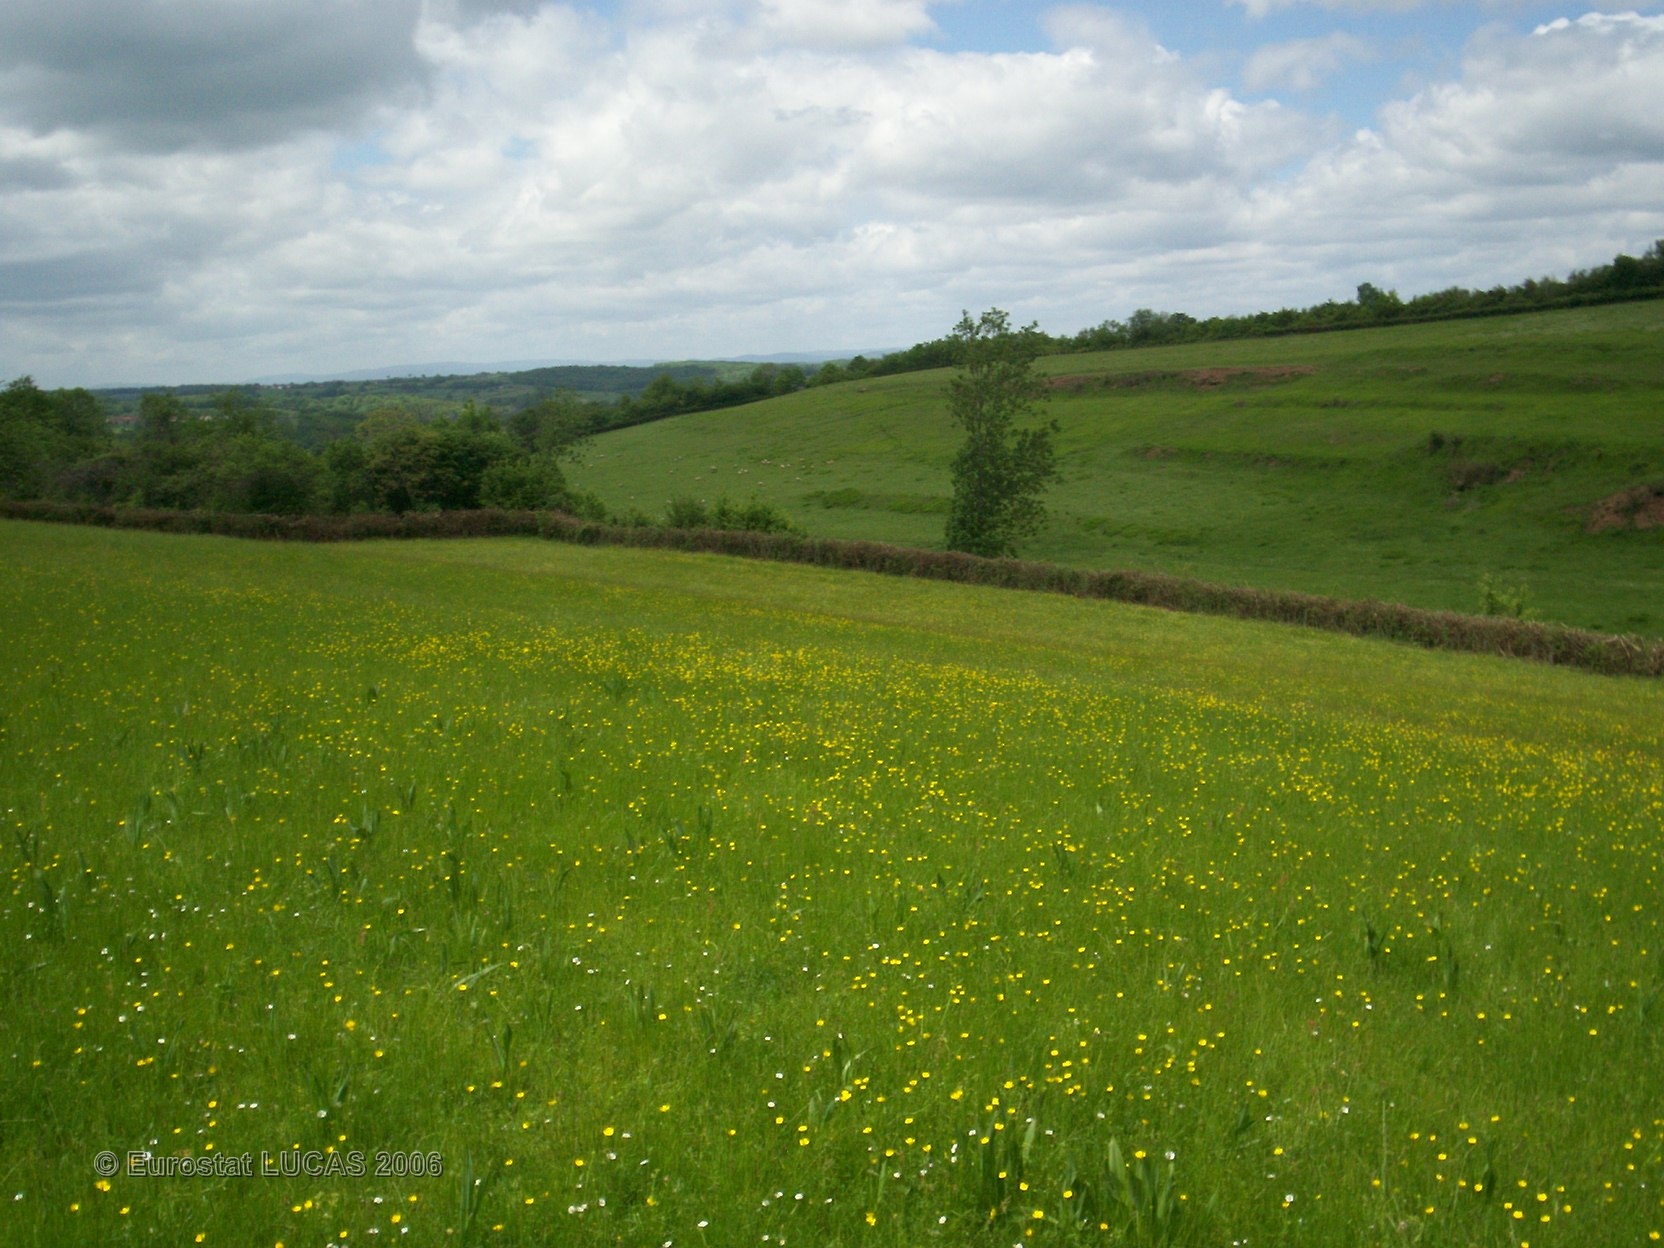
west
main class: Grassland
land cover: Grassland without tree/shrub cover
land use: Agriculture (excluding fallow land and kitchen gardens)
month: May
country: FR
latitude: 47.0445
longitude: 4.5907
